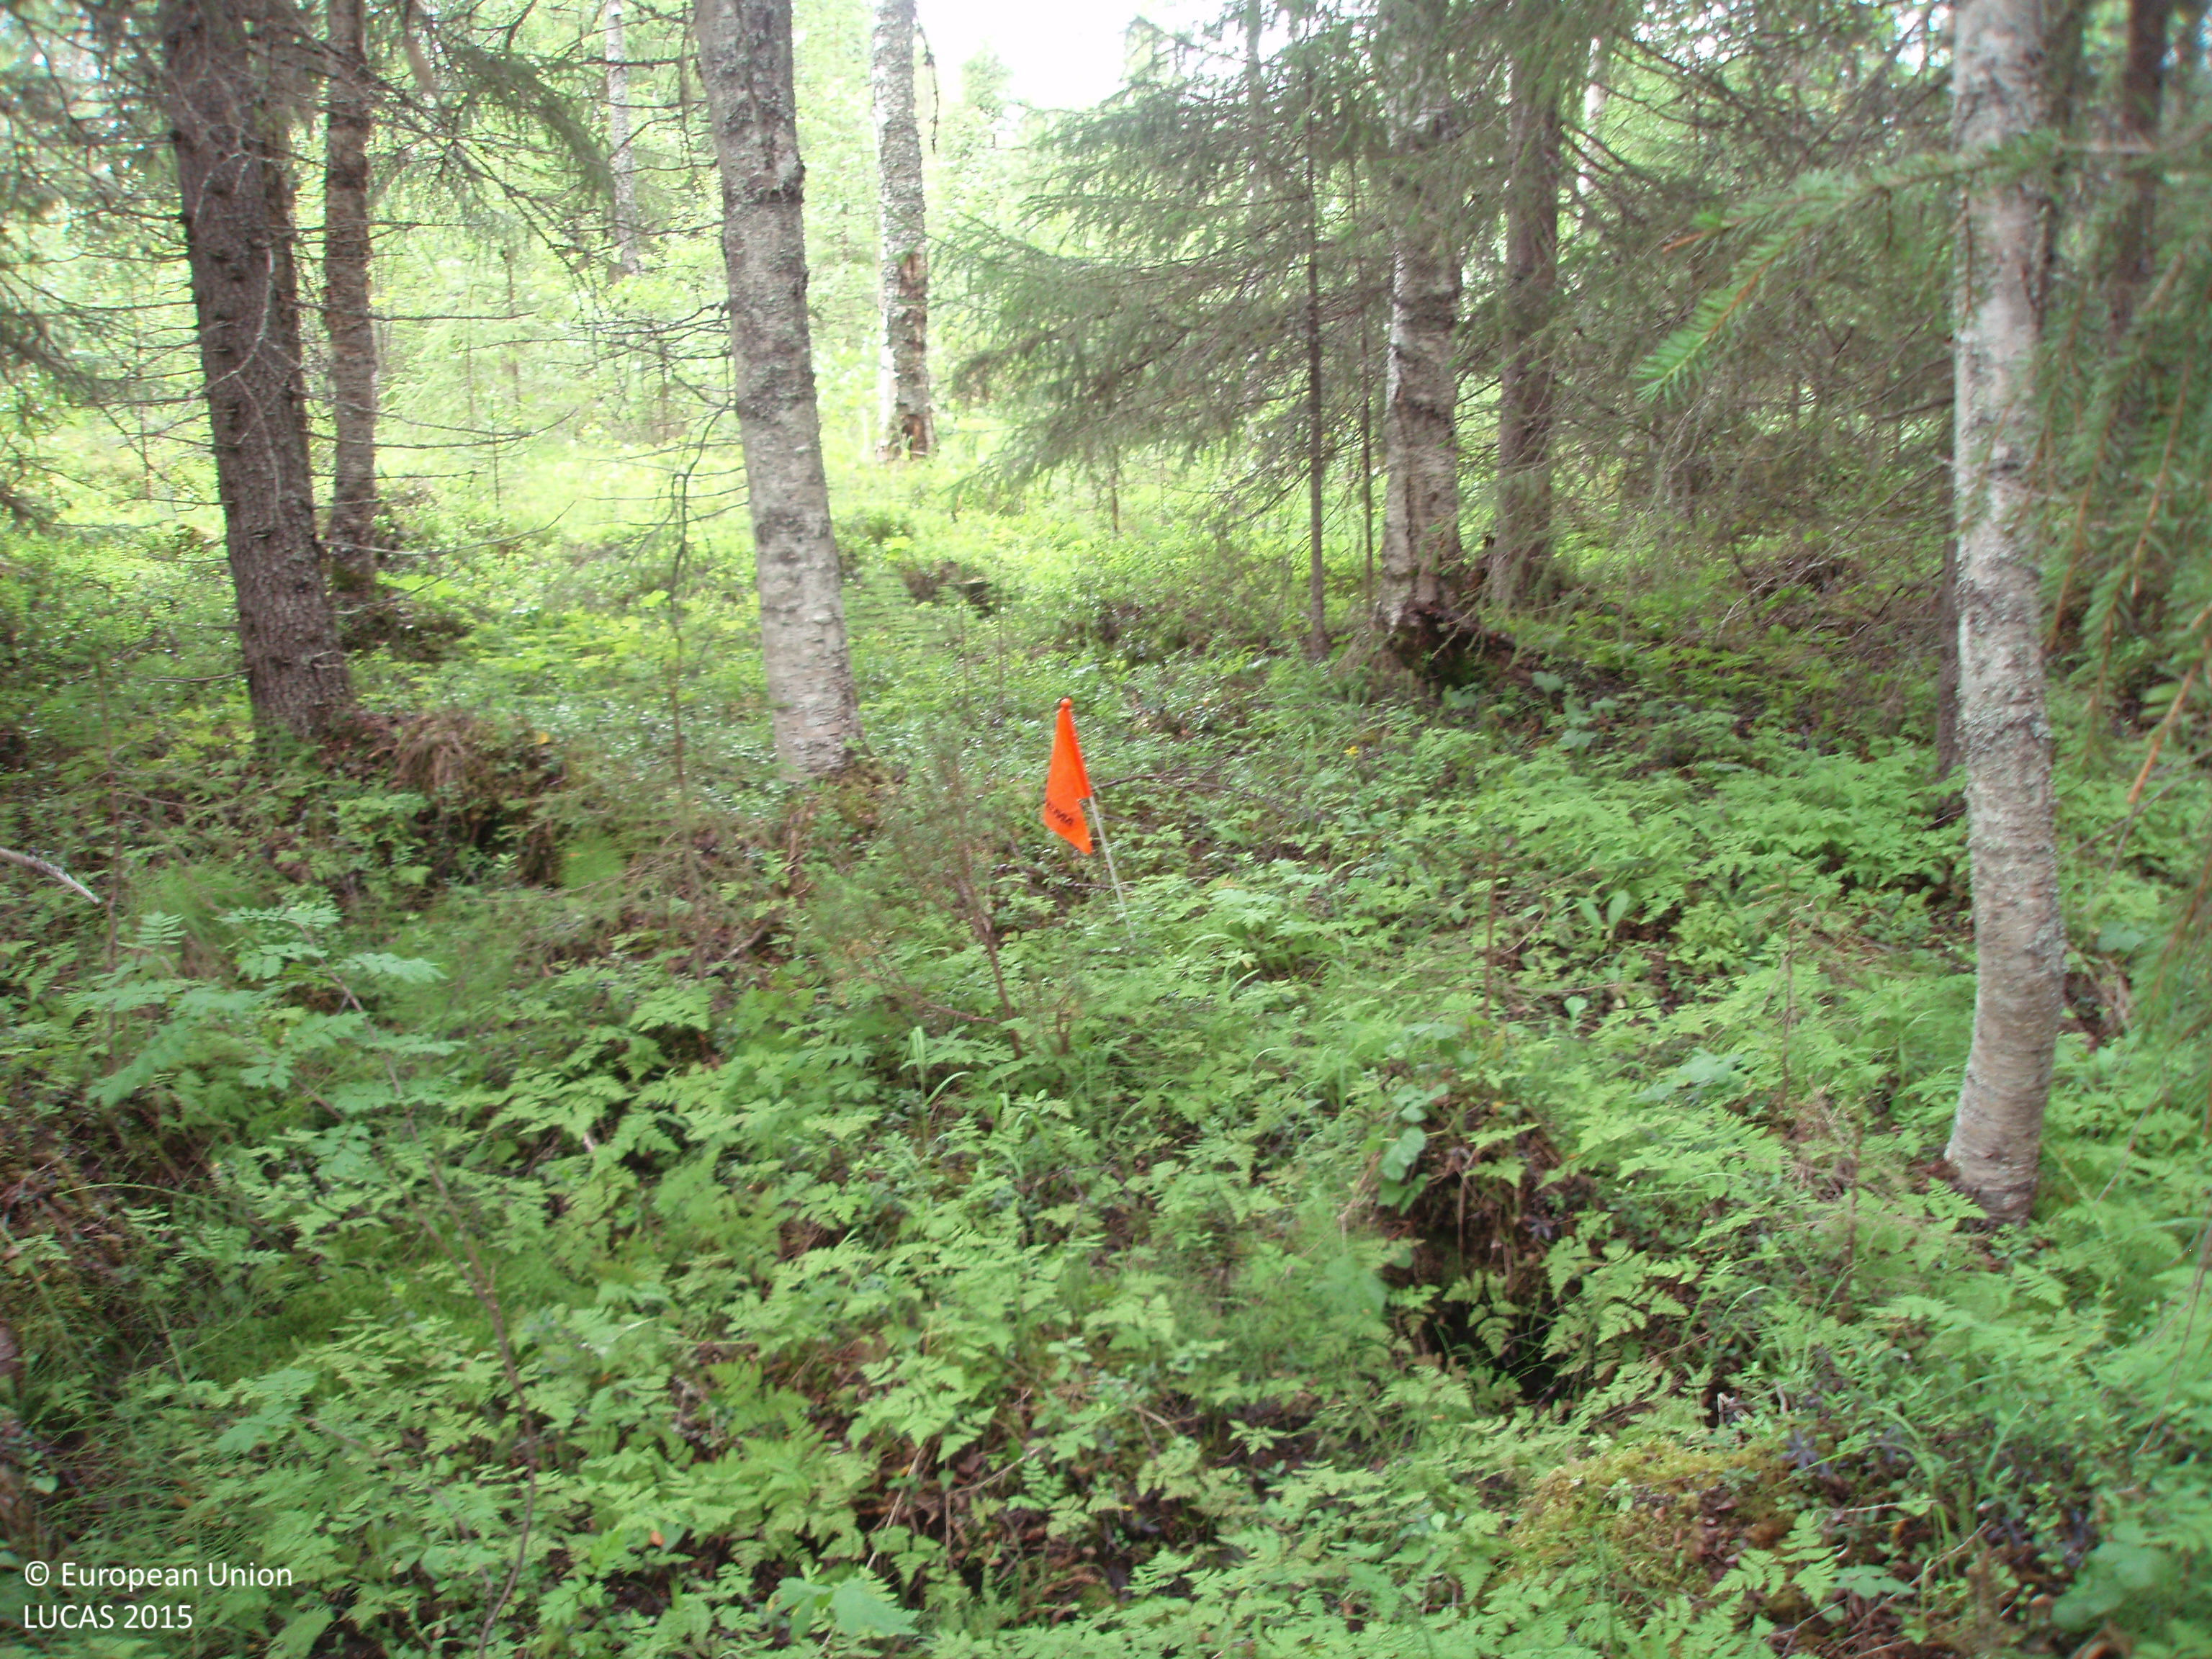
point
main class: Woodland
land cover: Spruce dominated mixed woodland
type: boreal forest
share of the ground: > 75 %
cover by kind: coniferous forest trees 45 %, broadleaved forest trees 40 %, shrubs 15 %
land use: Forestry
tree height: > 5 m
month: July
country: FI
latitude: 65.6612
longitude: 27.7258
